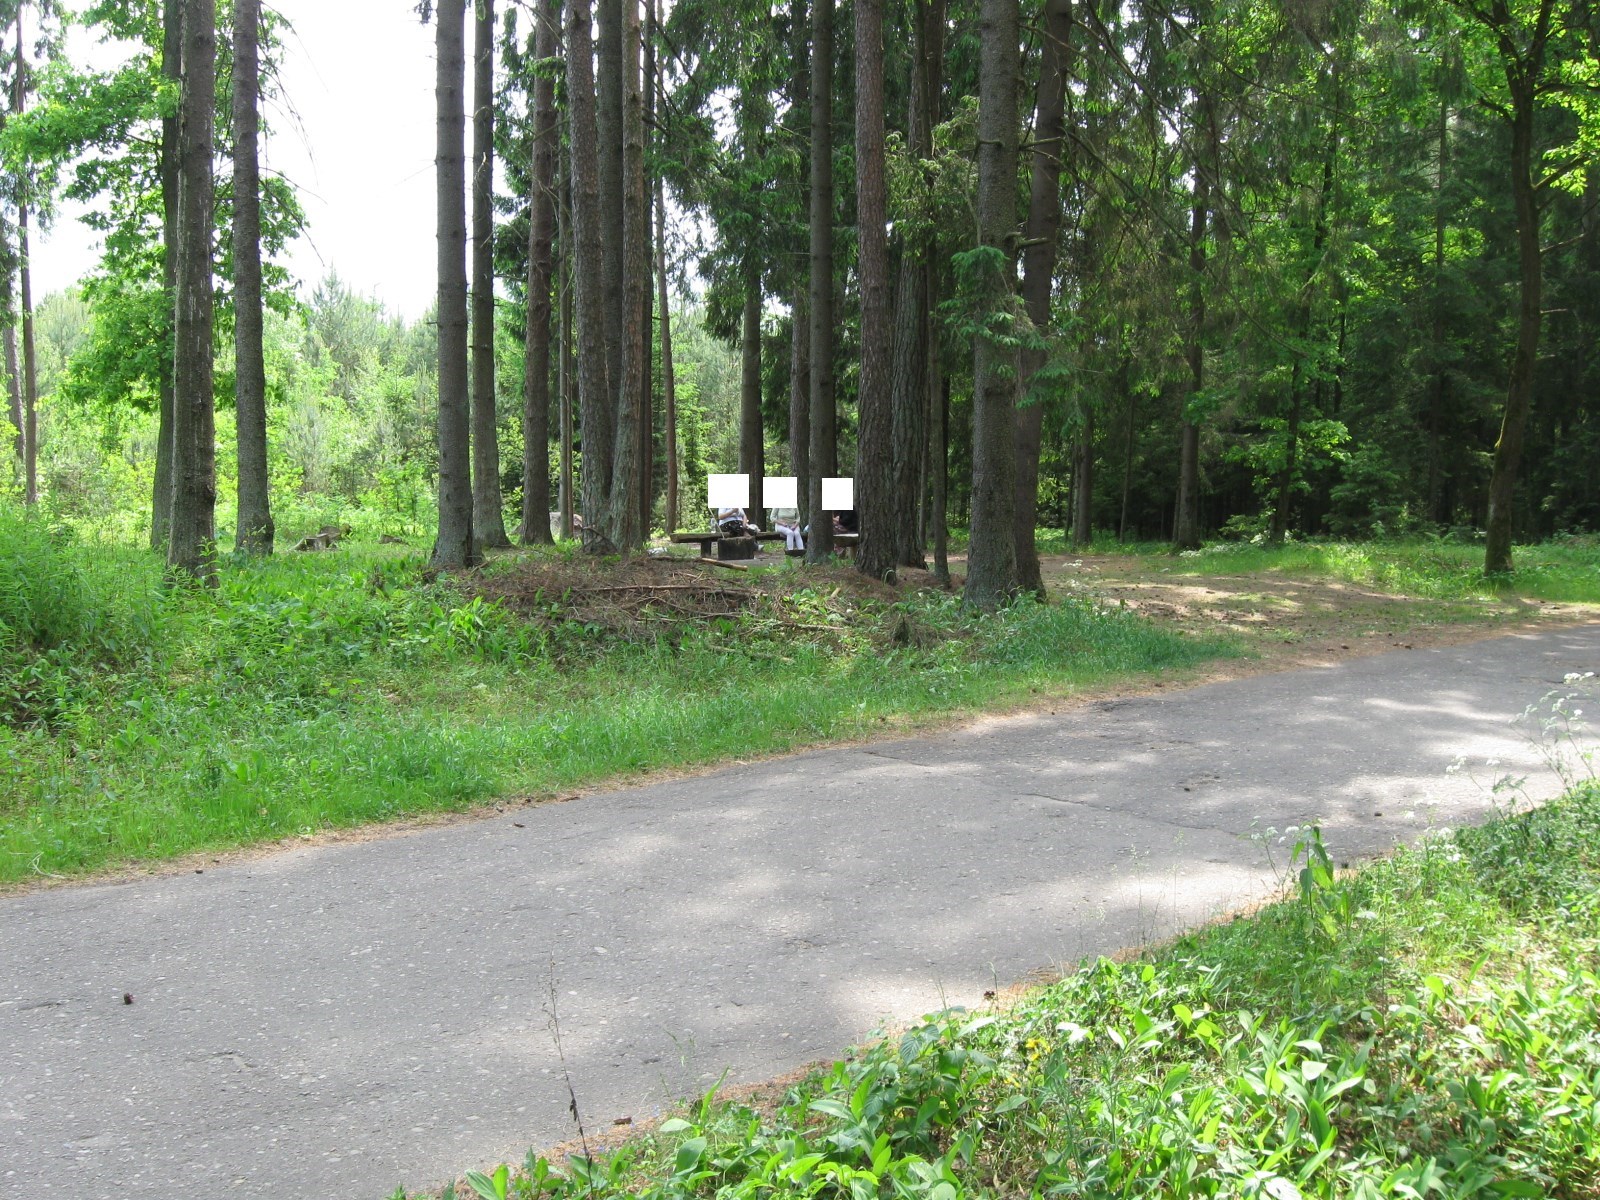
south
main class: Woodland
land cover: Spruce dominated coniferous woodland
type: hemiboreal forest and nemoral coniferous forest and mixed broadleaved-coniferous forest
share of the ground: > 75 %
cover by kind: coniferous forest trees 85 %, herbaceous plants 10 %, unconsolidated bare surface 5 %
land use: Forestry
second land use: Sport
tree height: > 5 m
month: June
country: LT
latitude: 54.9433
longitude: 23.9684
